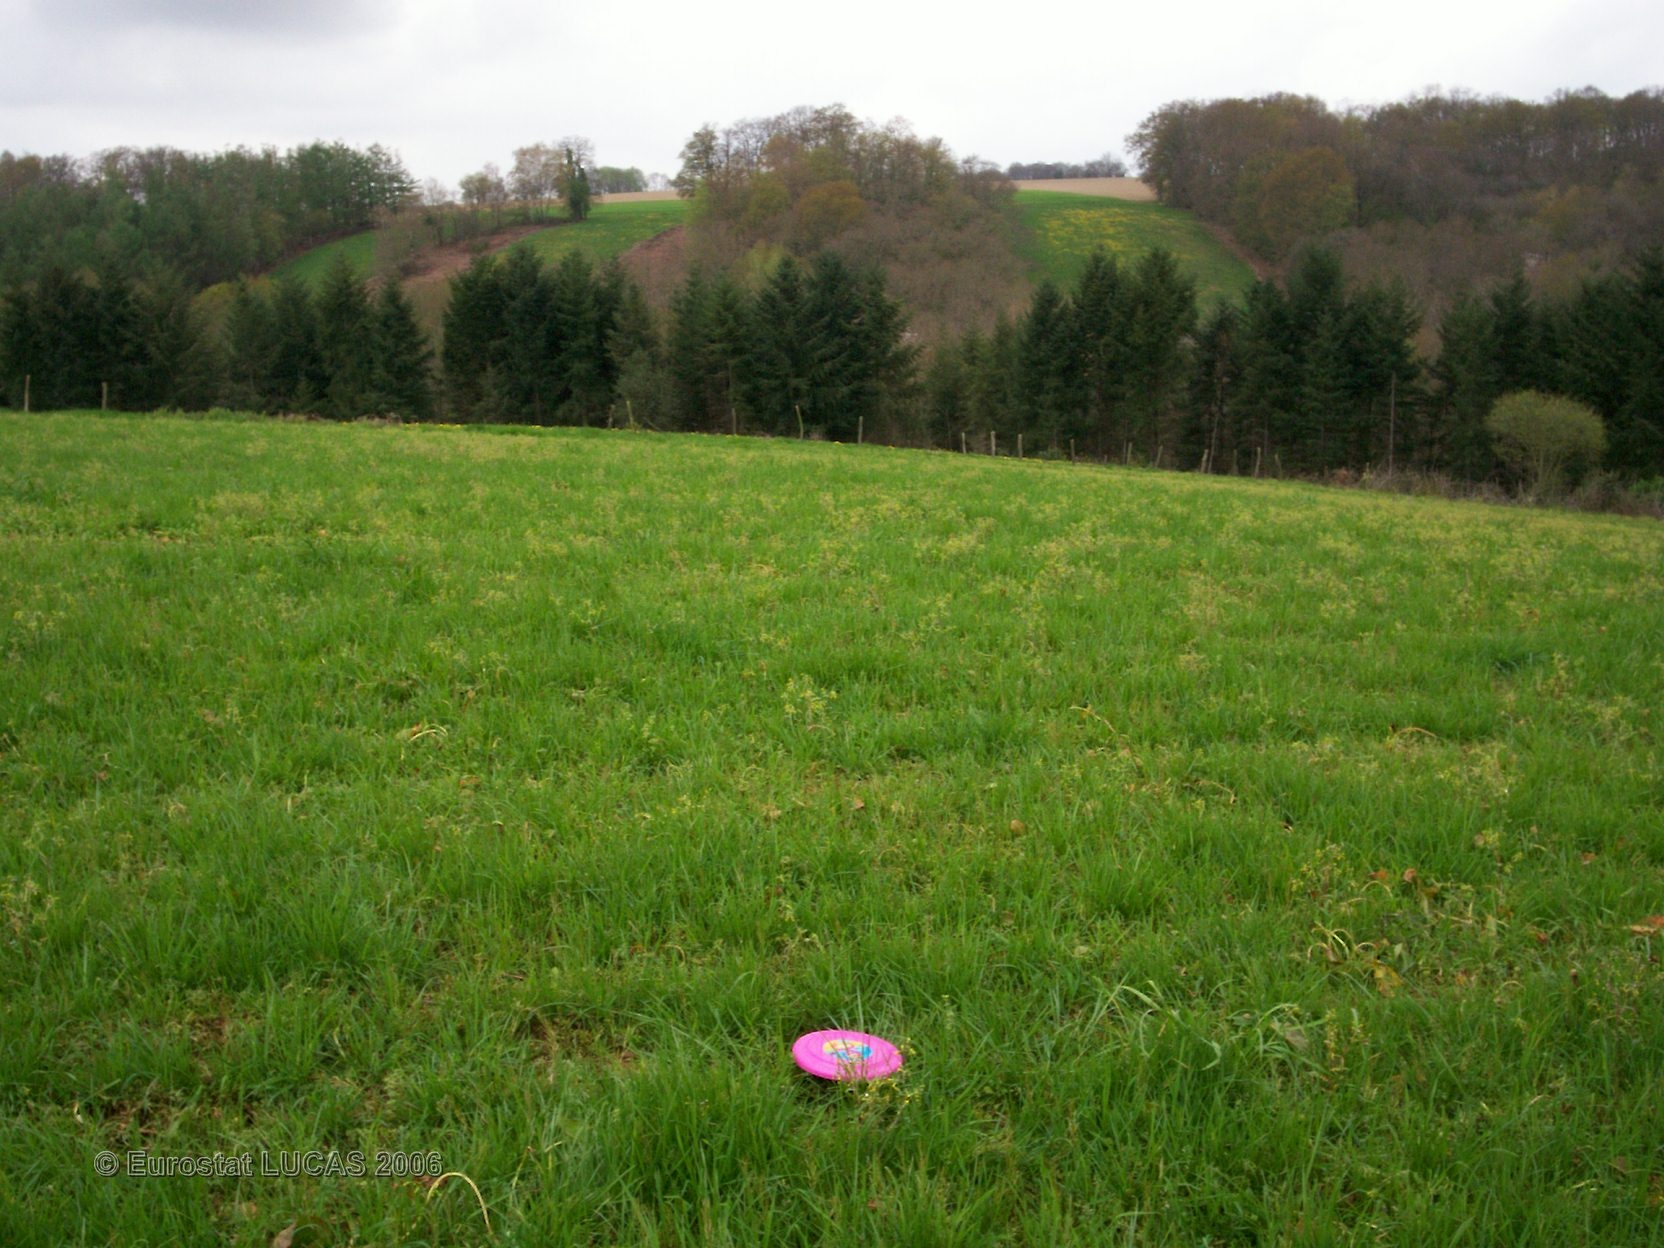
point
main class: Grassland
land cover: Grassland without tree/shrub cover
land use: Agriculture (excluding fallow land and kitchen gardens)
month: April
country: FR
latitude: 43.3933
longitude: -0.1913
